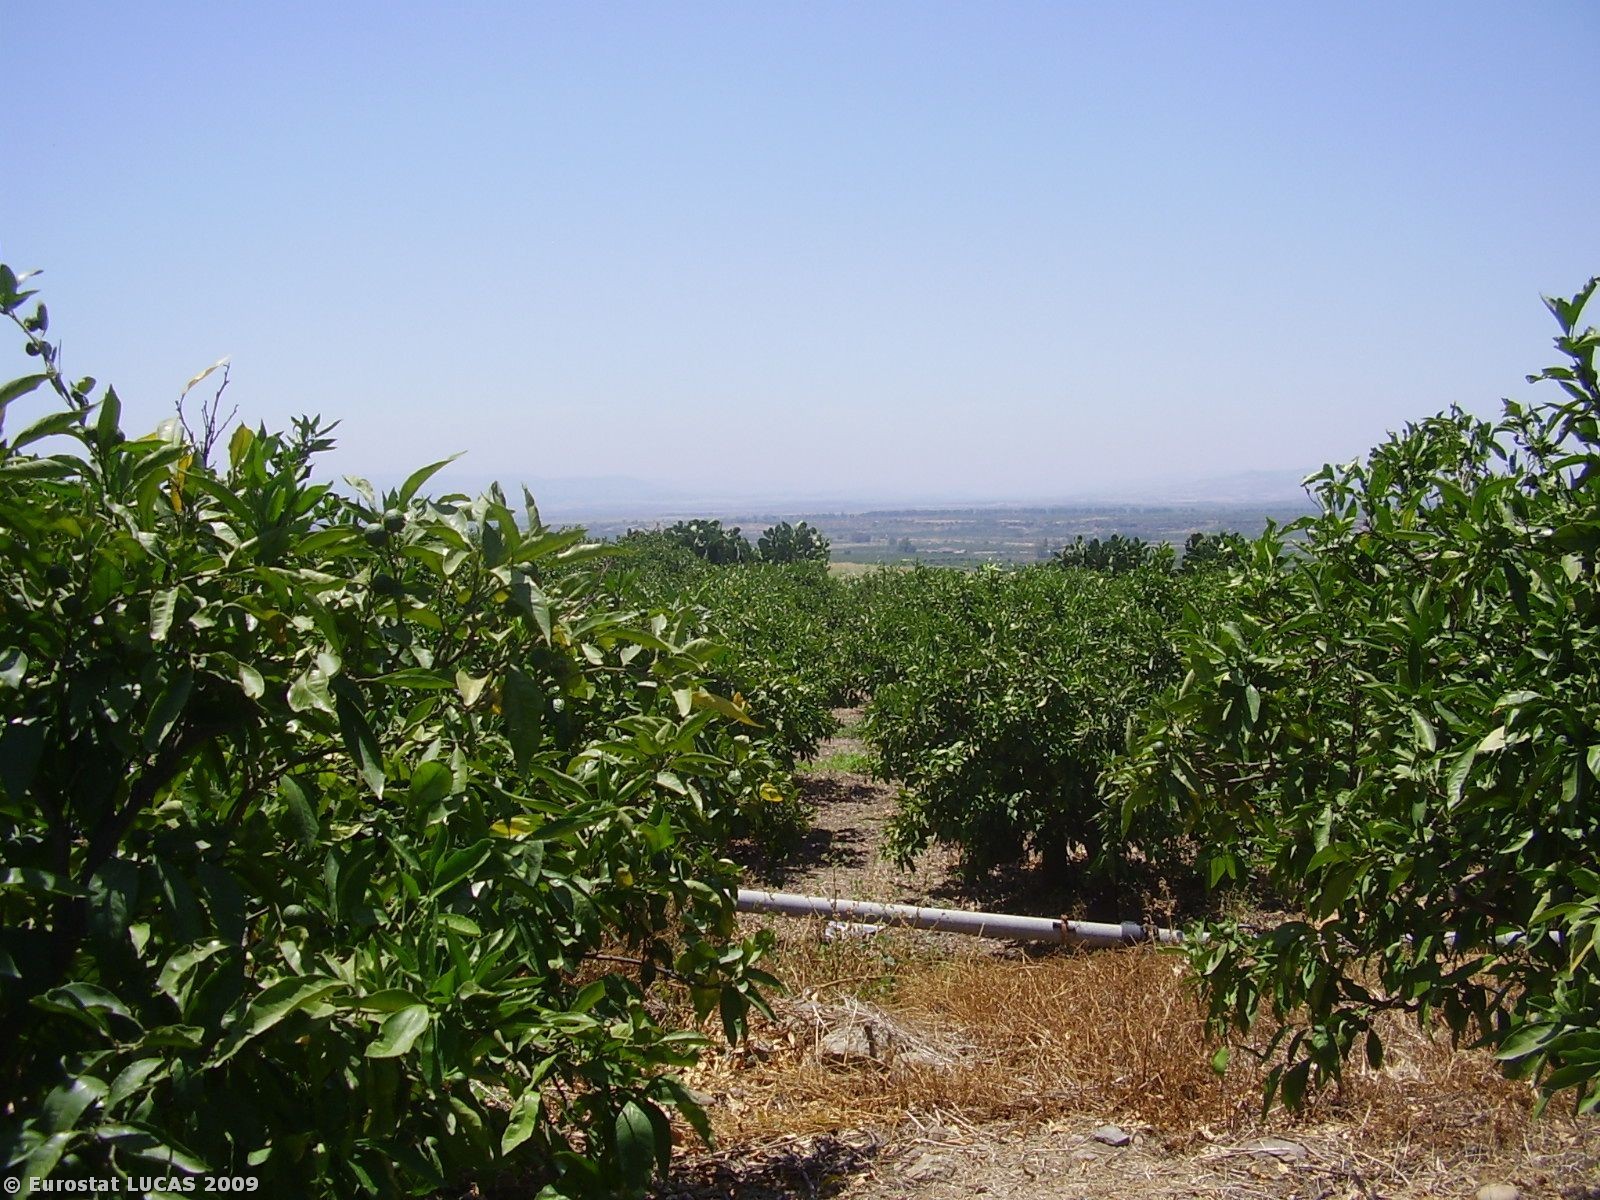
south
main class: Cropland
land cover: Oranges
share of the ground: 25 - 50 %
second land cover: Bare land
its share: > 75 %
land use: Agriculture (excluding fallow land and kitchen gardens)
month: June
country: IT
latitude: 37.5117
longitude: 14.9085
